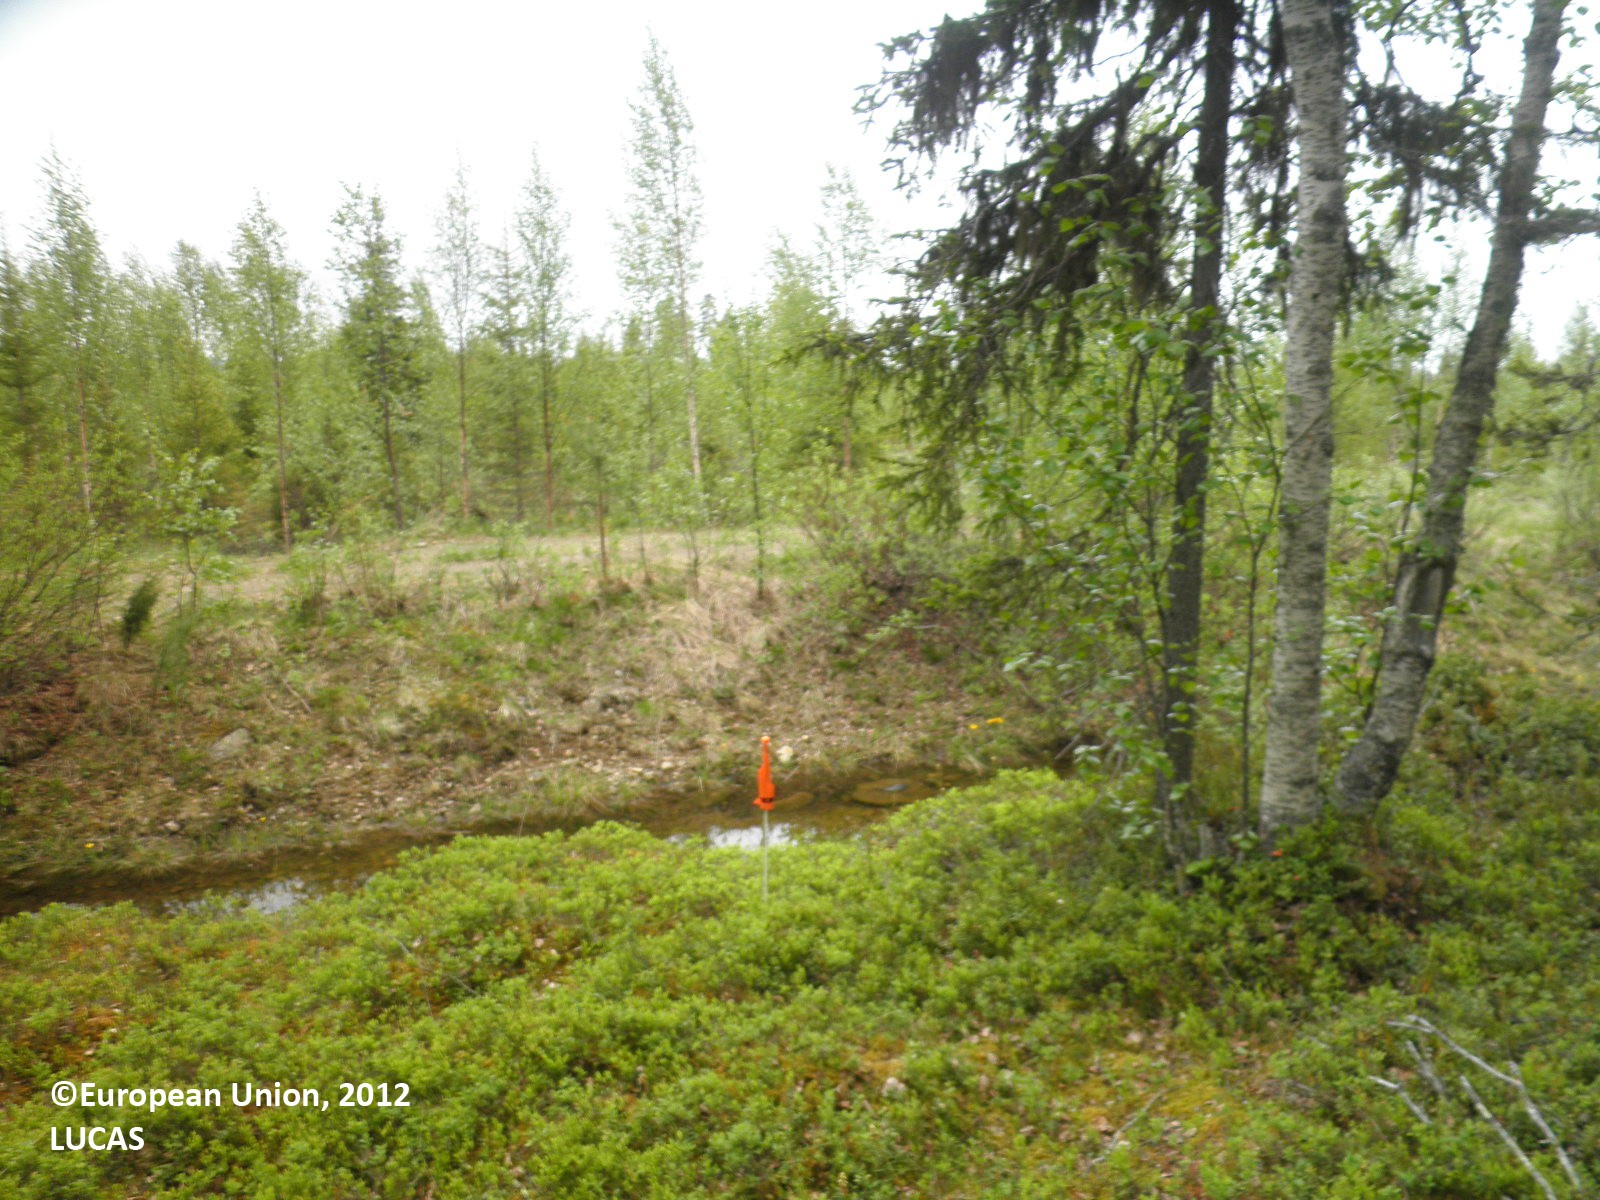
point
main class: Woodland
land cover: Spruce dominated mixed woodland
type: boreal forest
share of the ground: 25 - 50 %
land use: Forestry
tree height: > 5 m
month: June
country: FI
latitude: 67.8191
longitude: 25.6897
